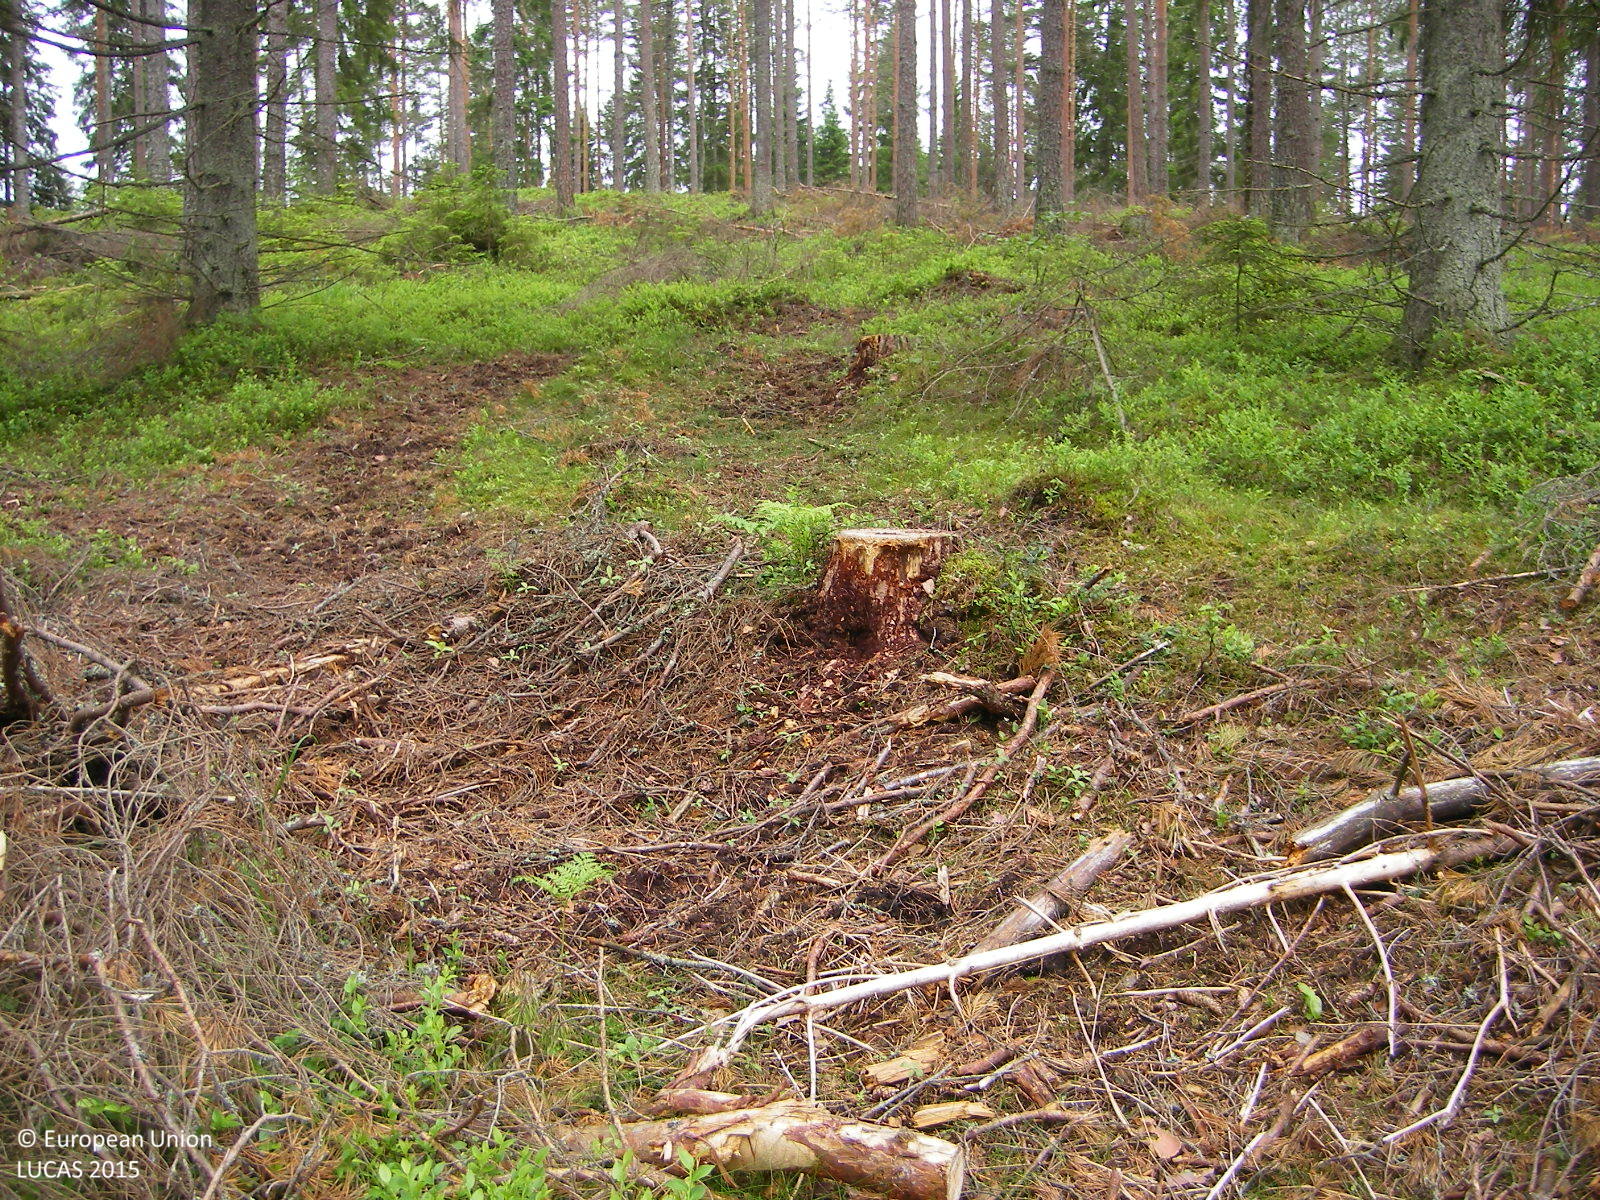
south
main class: Woodland
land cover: Other coniferous woodland
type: boreal forest
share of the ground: 50 - 75 %
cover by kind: coniferous forest trees 60 %, shrubs 25 %, unconsolidated bare surface 10 %, lichens and mosses 5 %
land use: Forestry
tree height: > 5 m
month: June
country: FI
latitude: 60.2434
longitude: 23.2887
